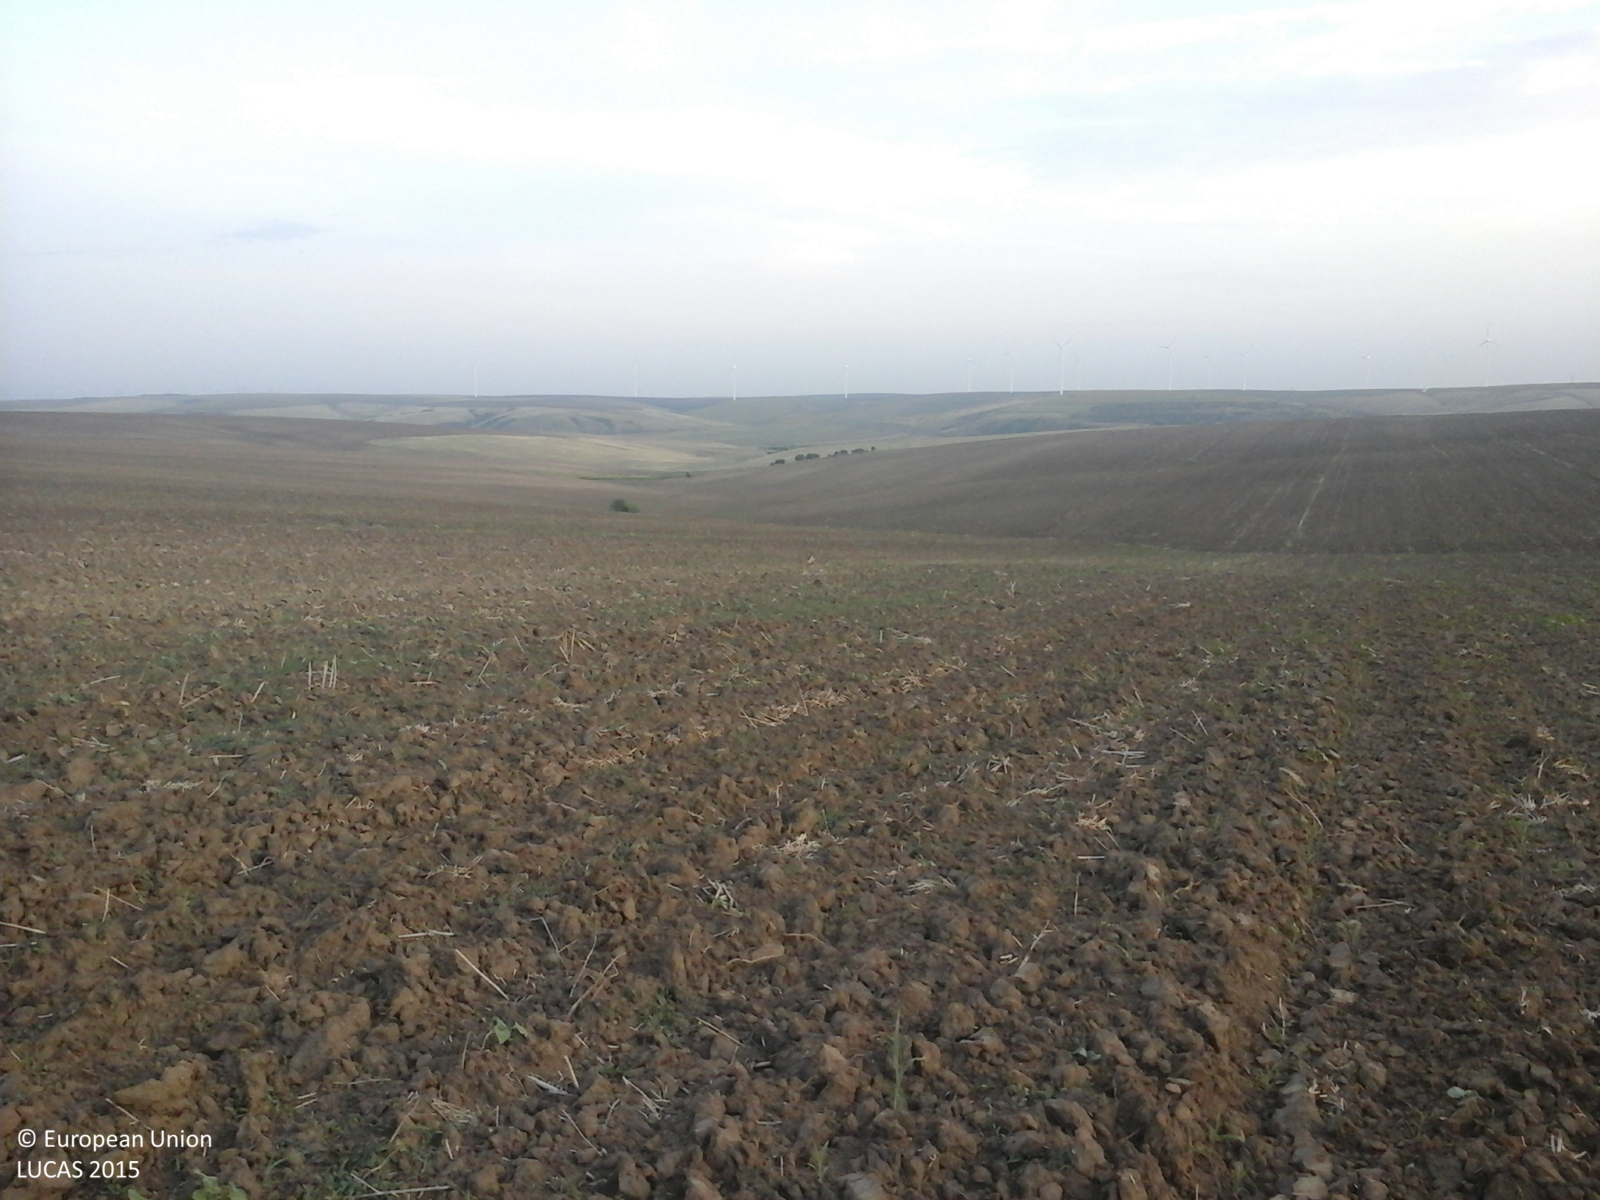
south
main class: Cropland
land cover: Rape and turnip rape
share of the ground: < 10 %
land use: Agriculture (excluding fallow land and kitchen gardens)
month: August
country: RO
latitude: 44.2411
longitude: 28.0757
